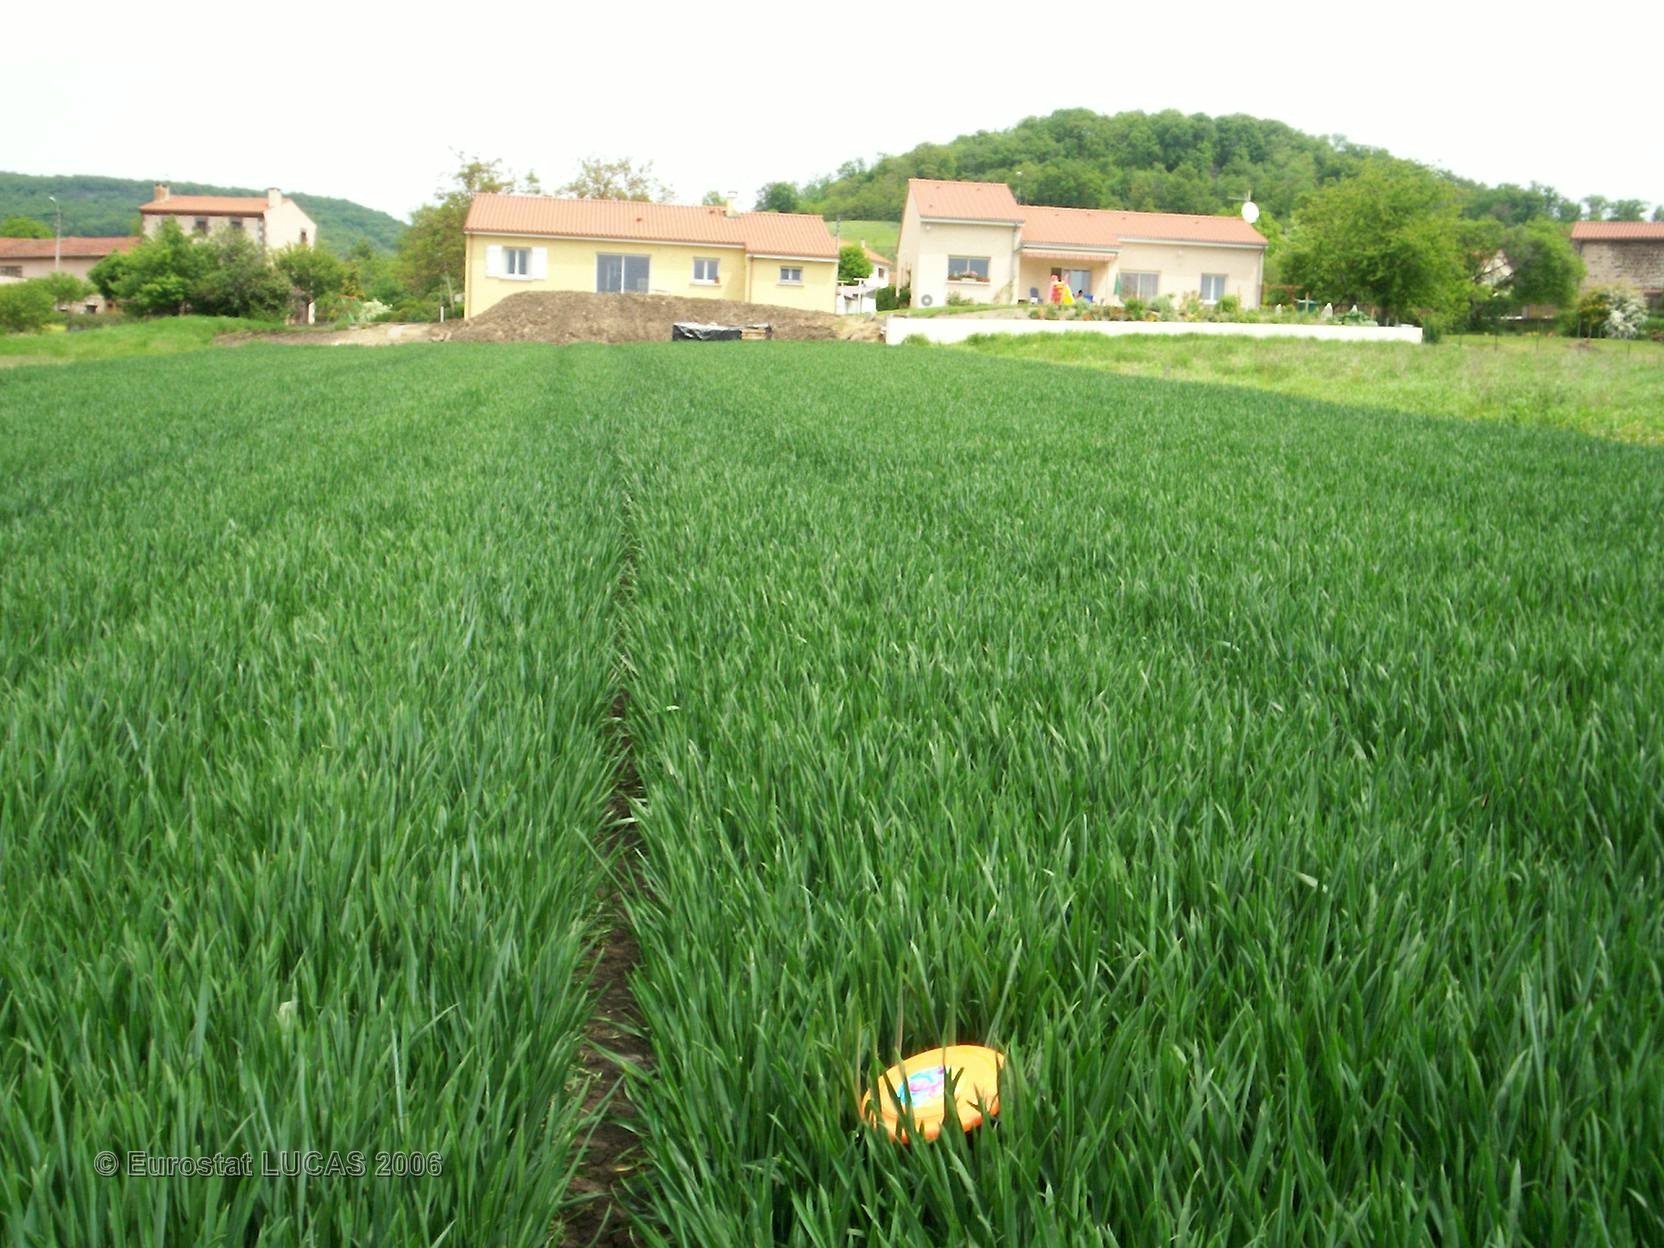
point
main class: Cropland
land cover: Common wheat
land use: Agriculture (excluding fallow land and kitchen gardens)
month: May
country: FR
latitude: 45.5986
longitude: 3.2961
